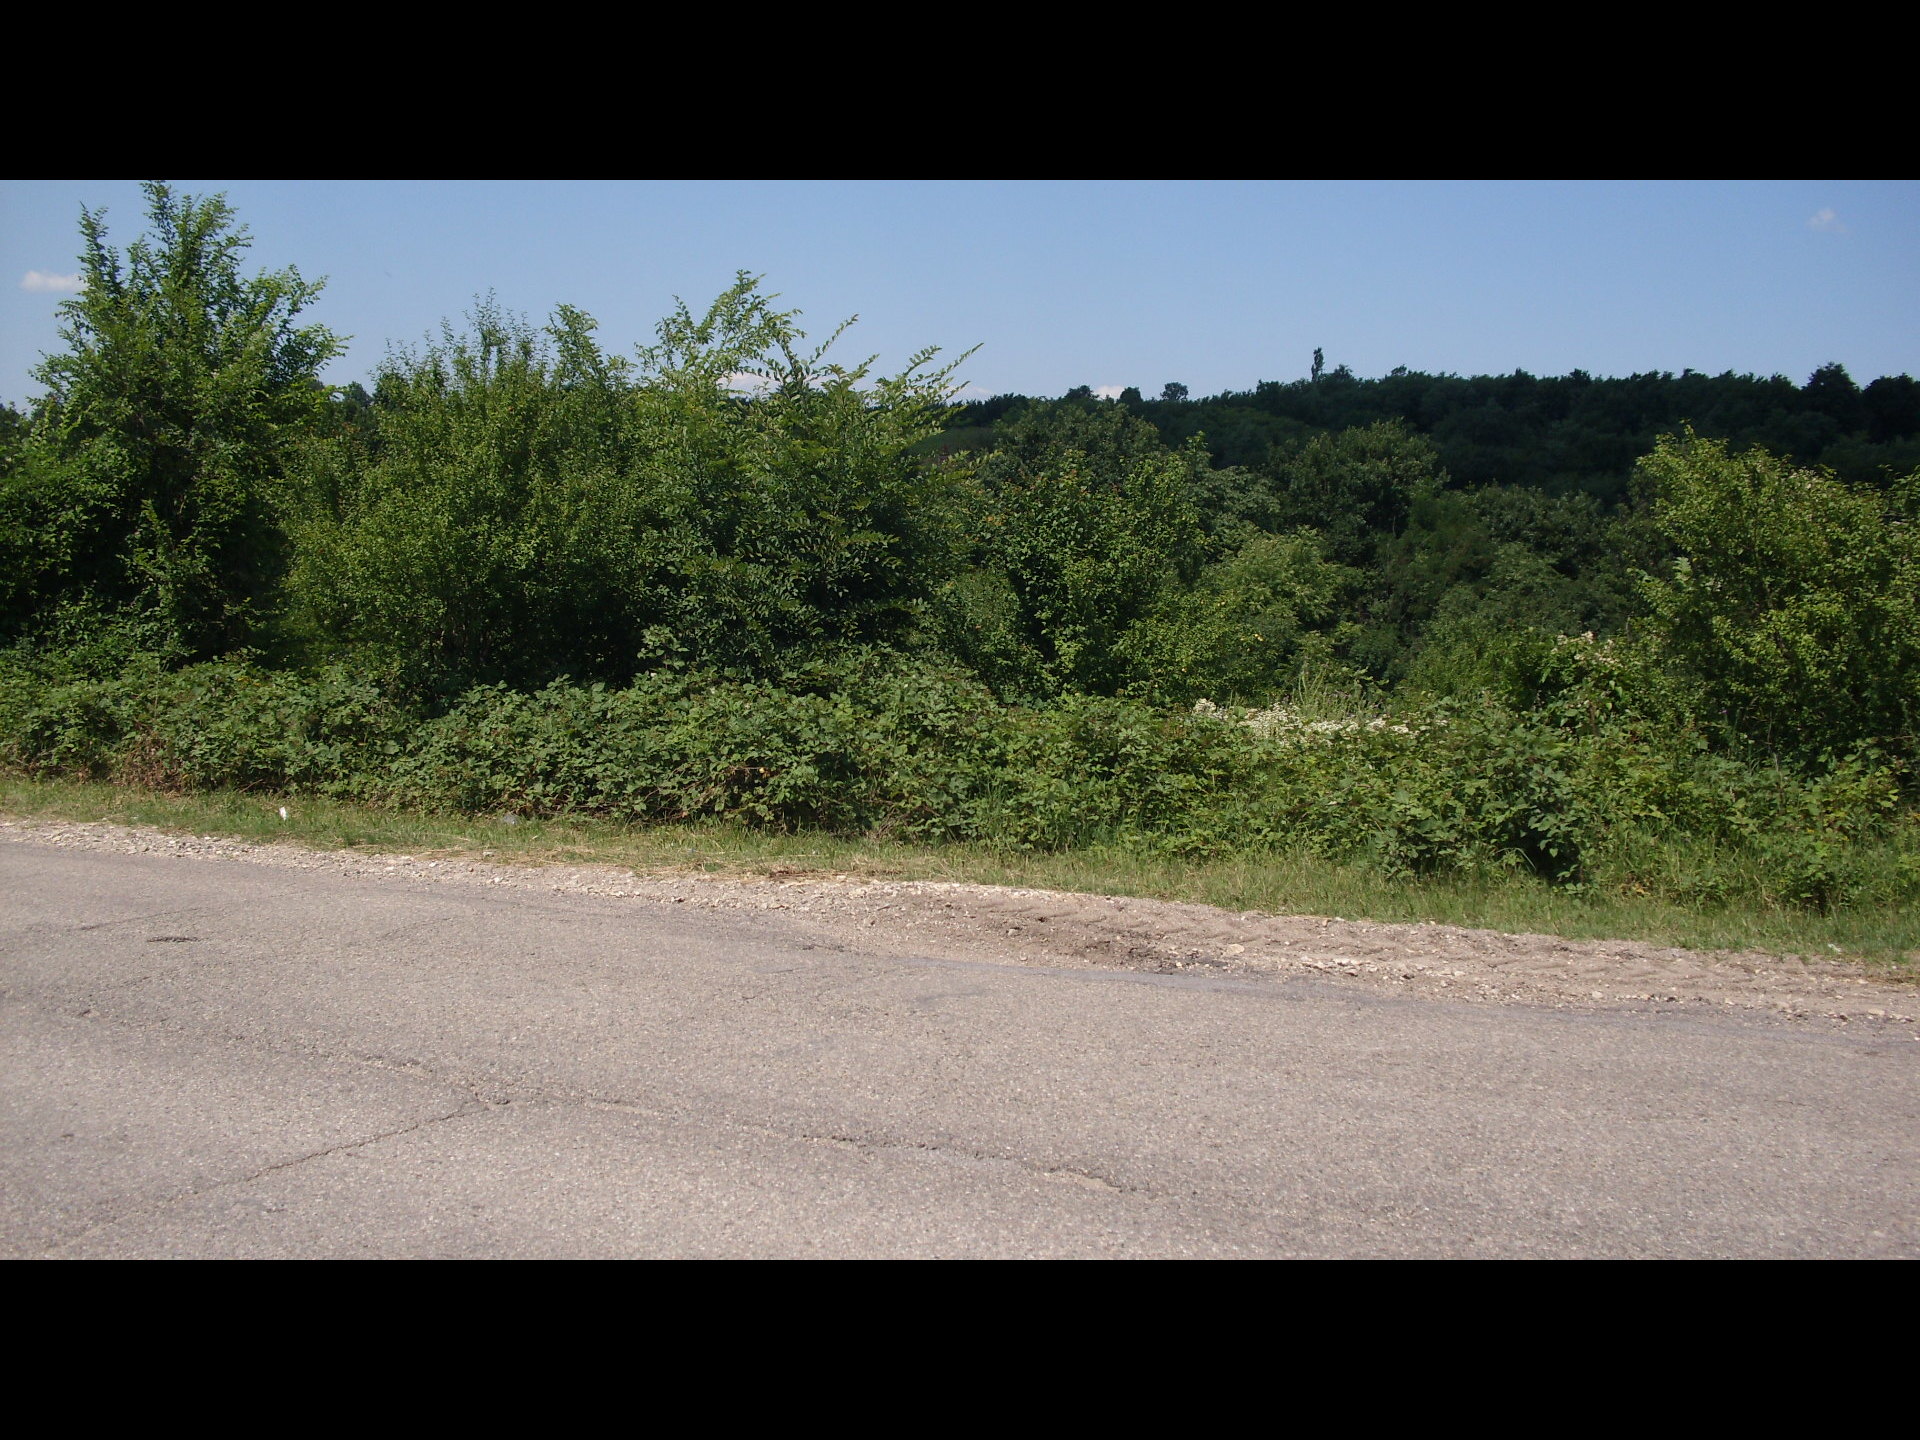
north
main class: Woodland
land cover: Broadleaved woodland
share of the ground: > 75 %
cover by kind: broadleaved forest trees 95 %, shrubs 5 %
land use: Semi-natural and natural areas not in use
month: July
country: BG
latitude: 43.6154
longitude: 23.0370
